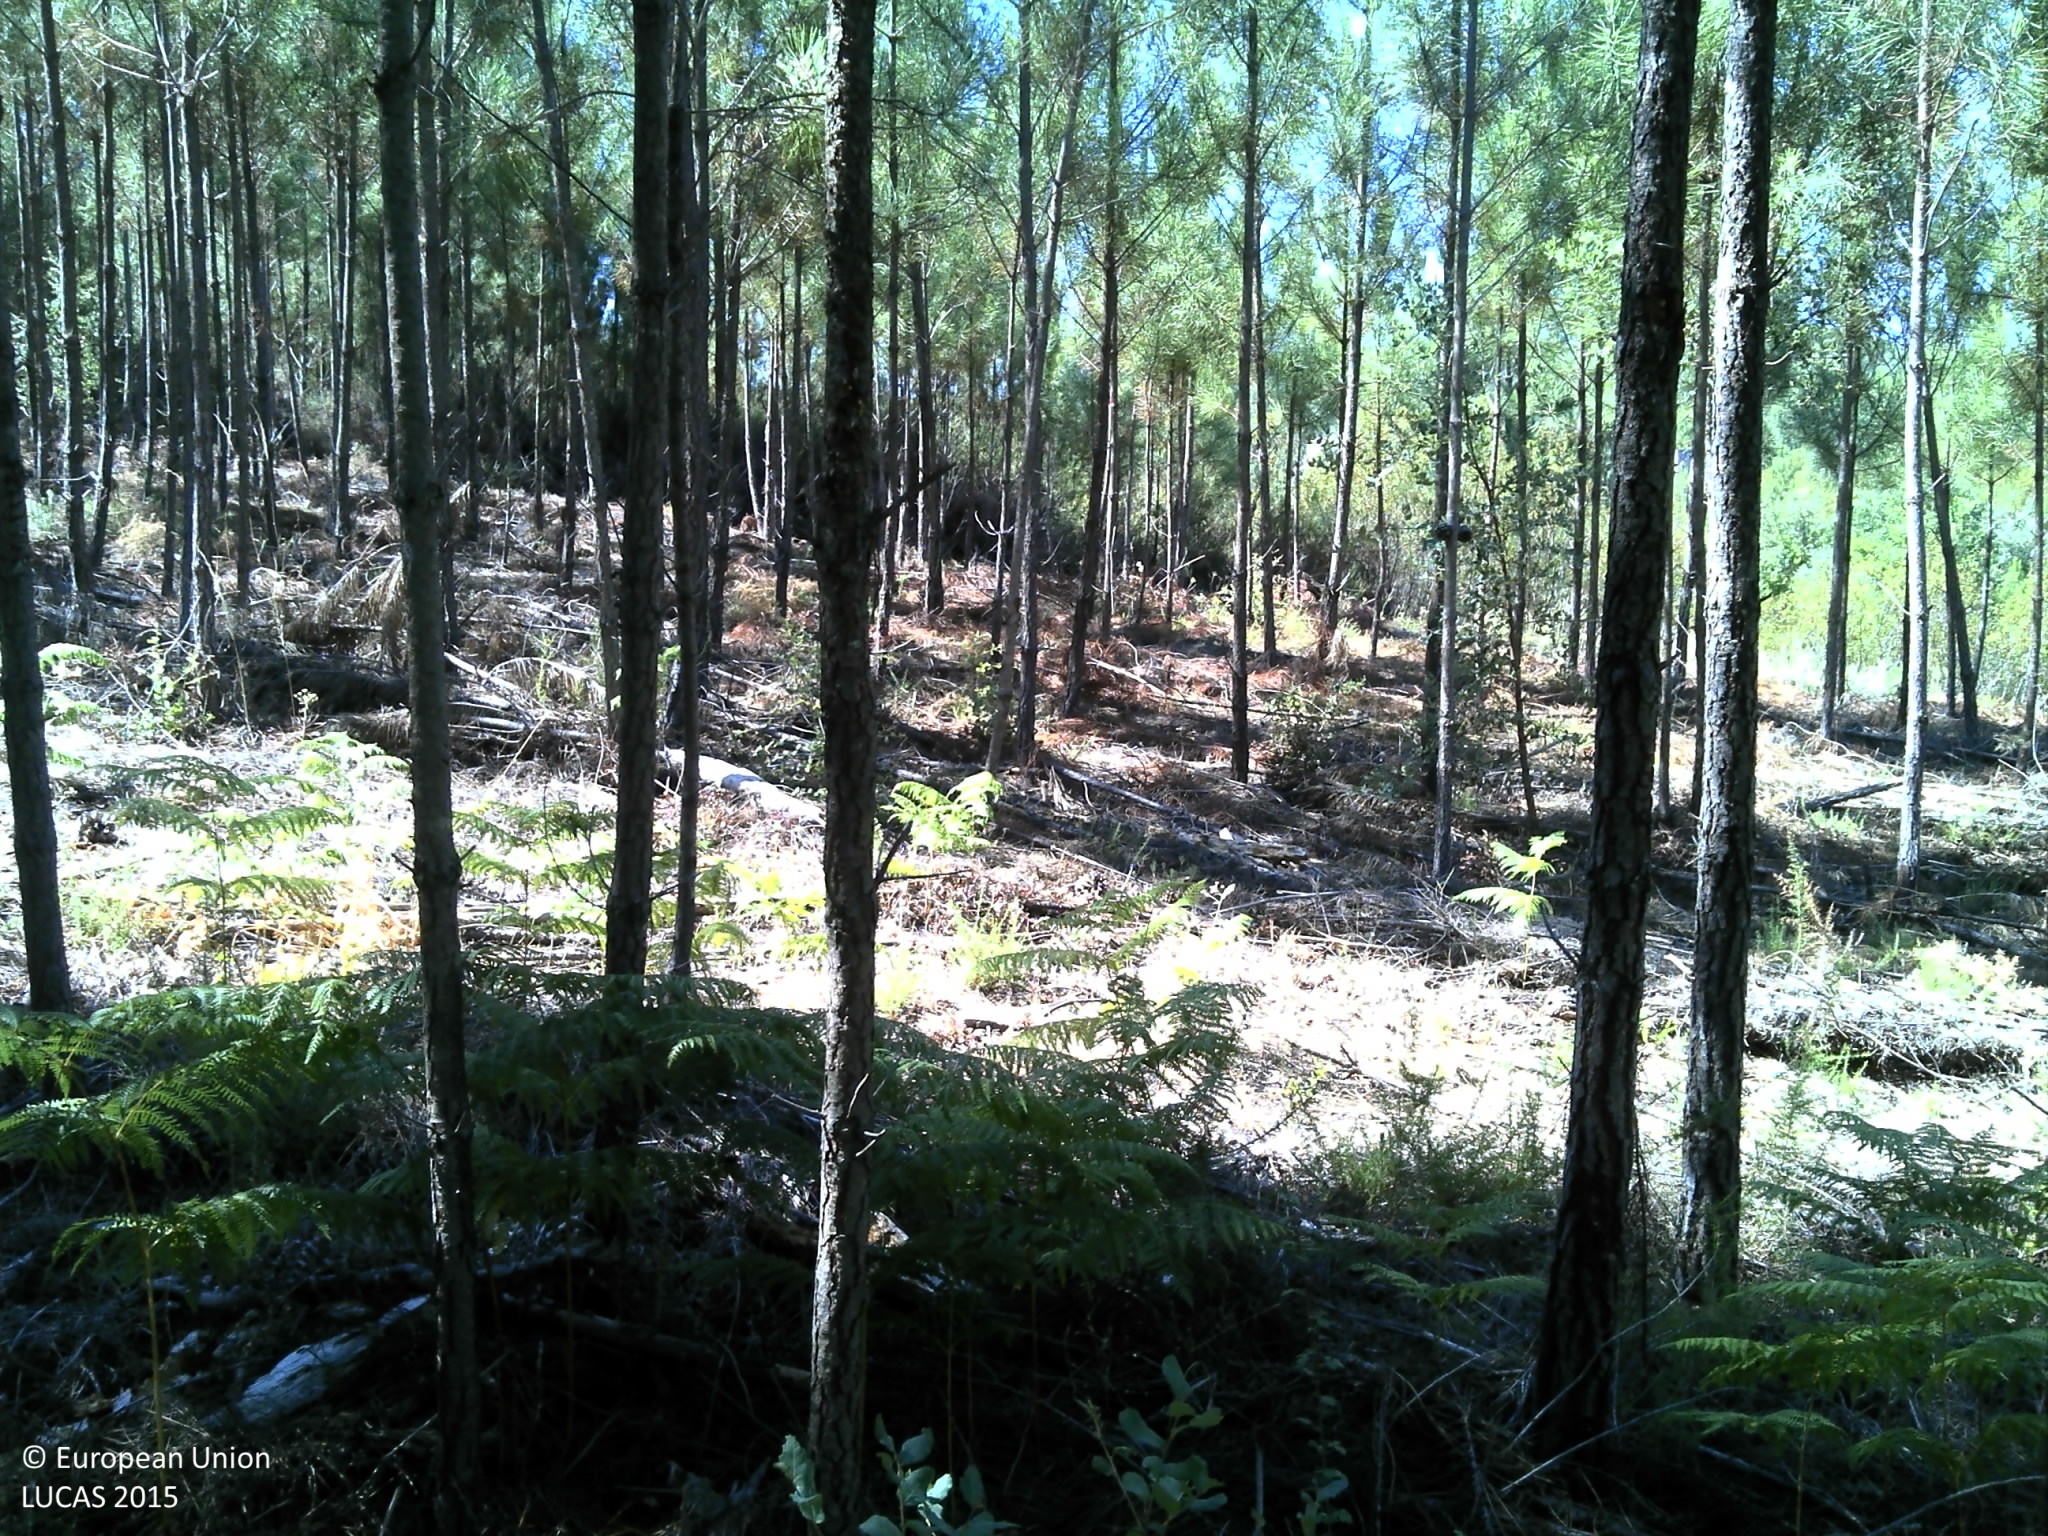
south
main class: Woodland
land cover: Pine dominated coniferous woodland
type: coniferous forest of the mediterranean region
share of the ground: 50 - 75 %
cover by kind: coniferous forest trees 50 %, shrubs 20 %, unconsolidated bare surface 10 %
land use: Forestry
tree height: > 5 m
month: July
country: PT
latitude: 39.7252
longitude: -8.1386
